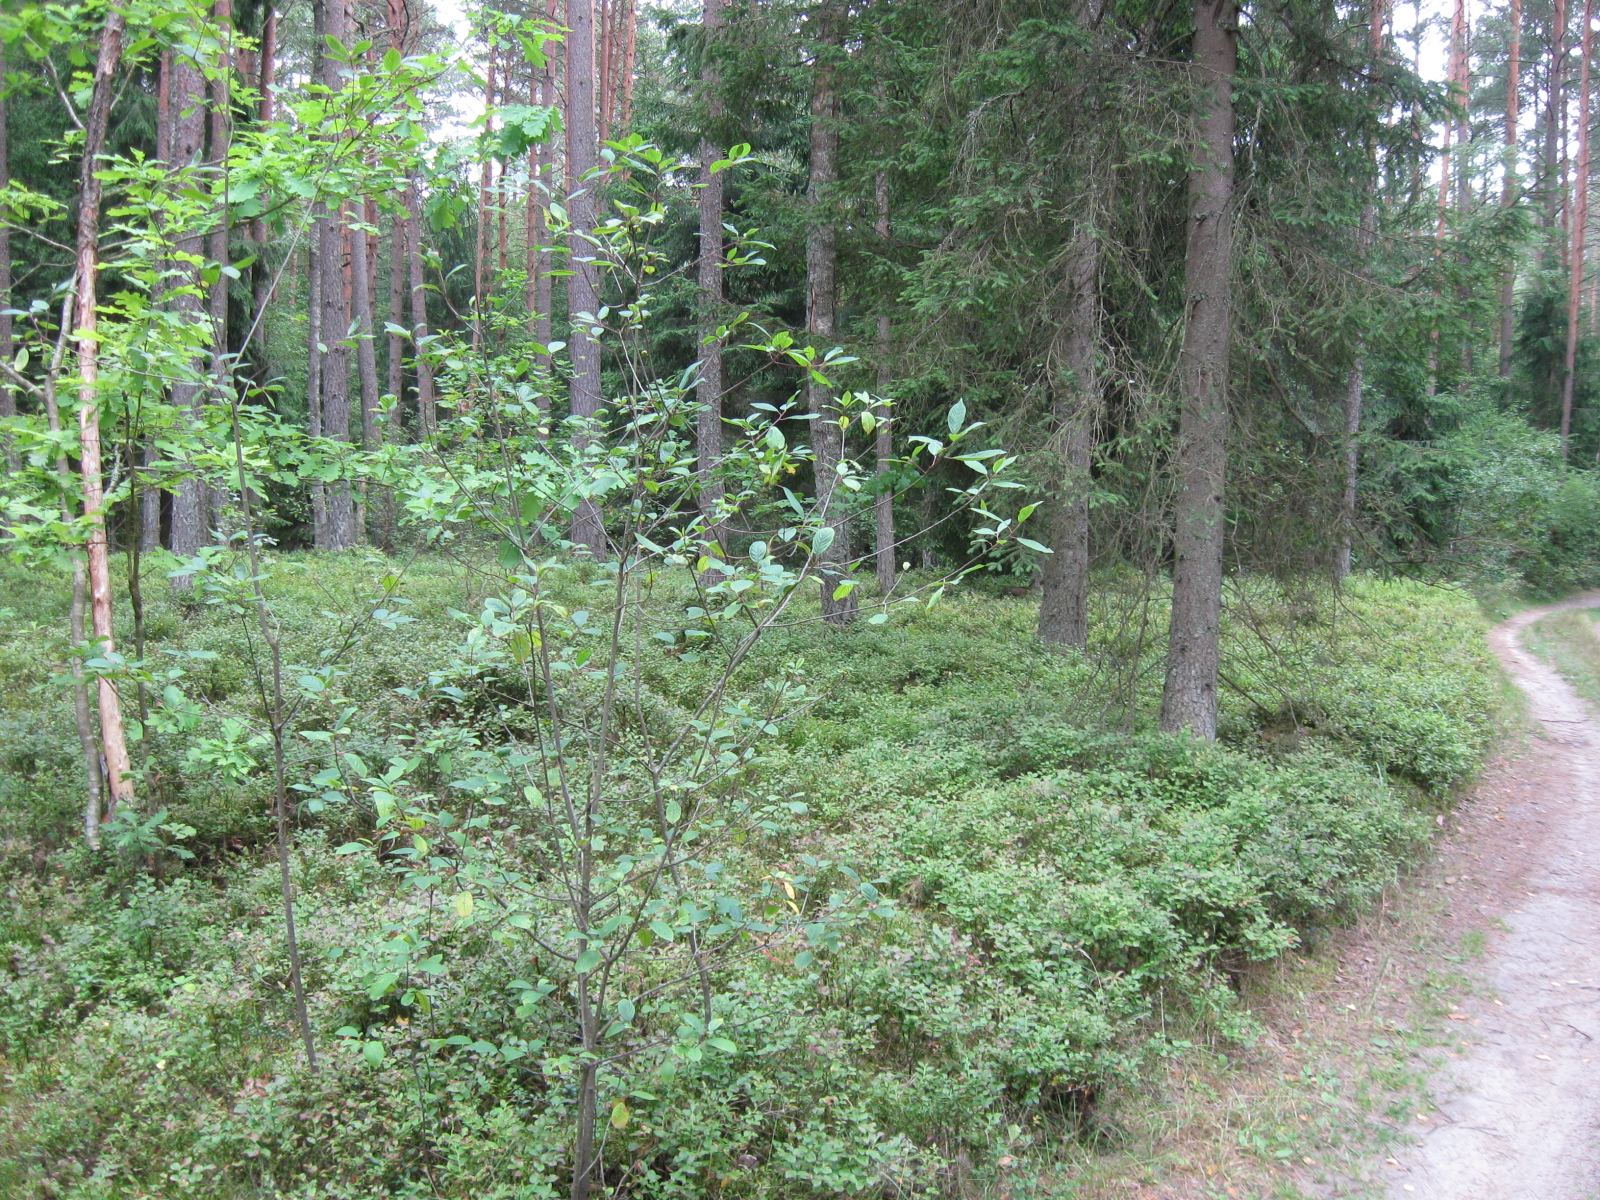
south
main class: Woodland
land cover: Pine dominated mixed woodland
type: hemiboreal forest and nemoral coniferous forest and mixed broadleaved-coniferous forest
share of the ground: > 75 %
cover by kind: coniferous forest trees 50 %, broadleaved forest trees 30 %, shrubs 10 %, herbaceous plants 5 %, lichens and mosses 5 %
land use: Forestry
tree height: > 5 m
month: July
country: LT
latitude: 54.8544
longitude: 23.6194
